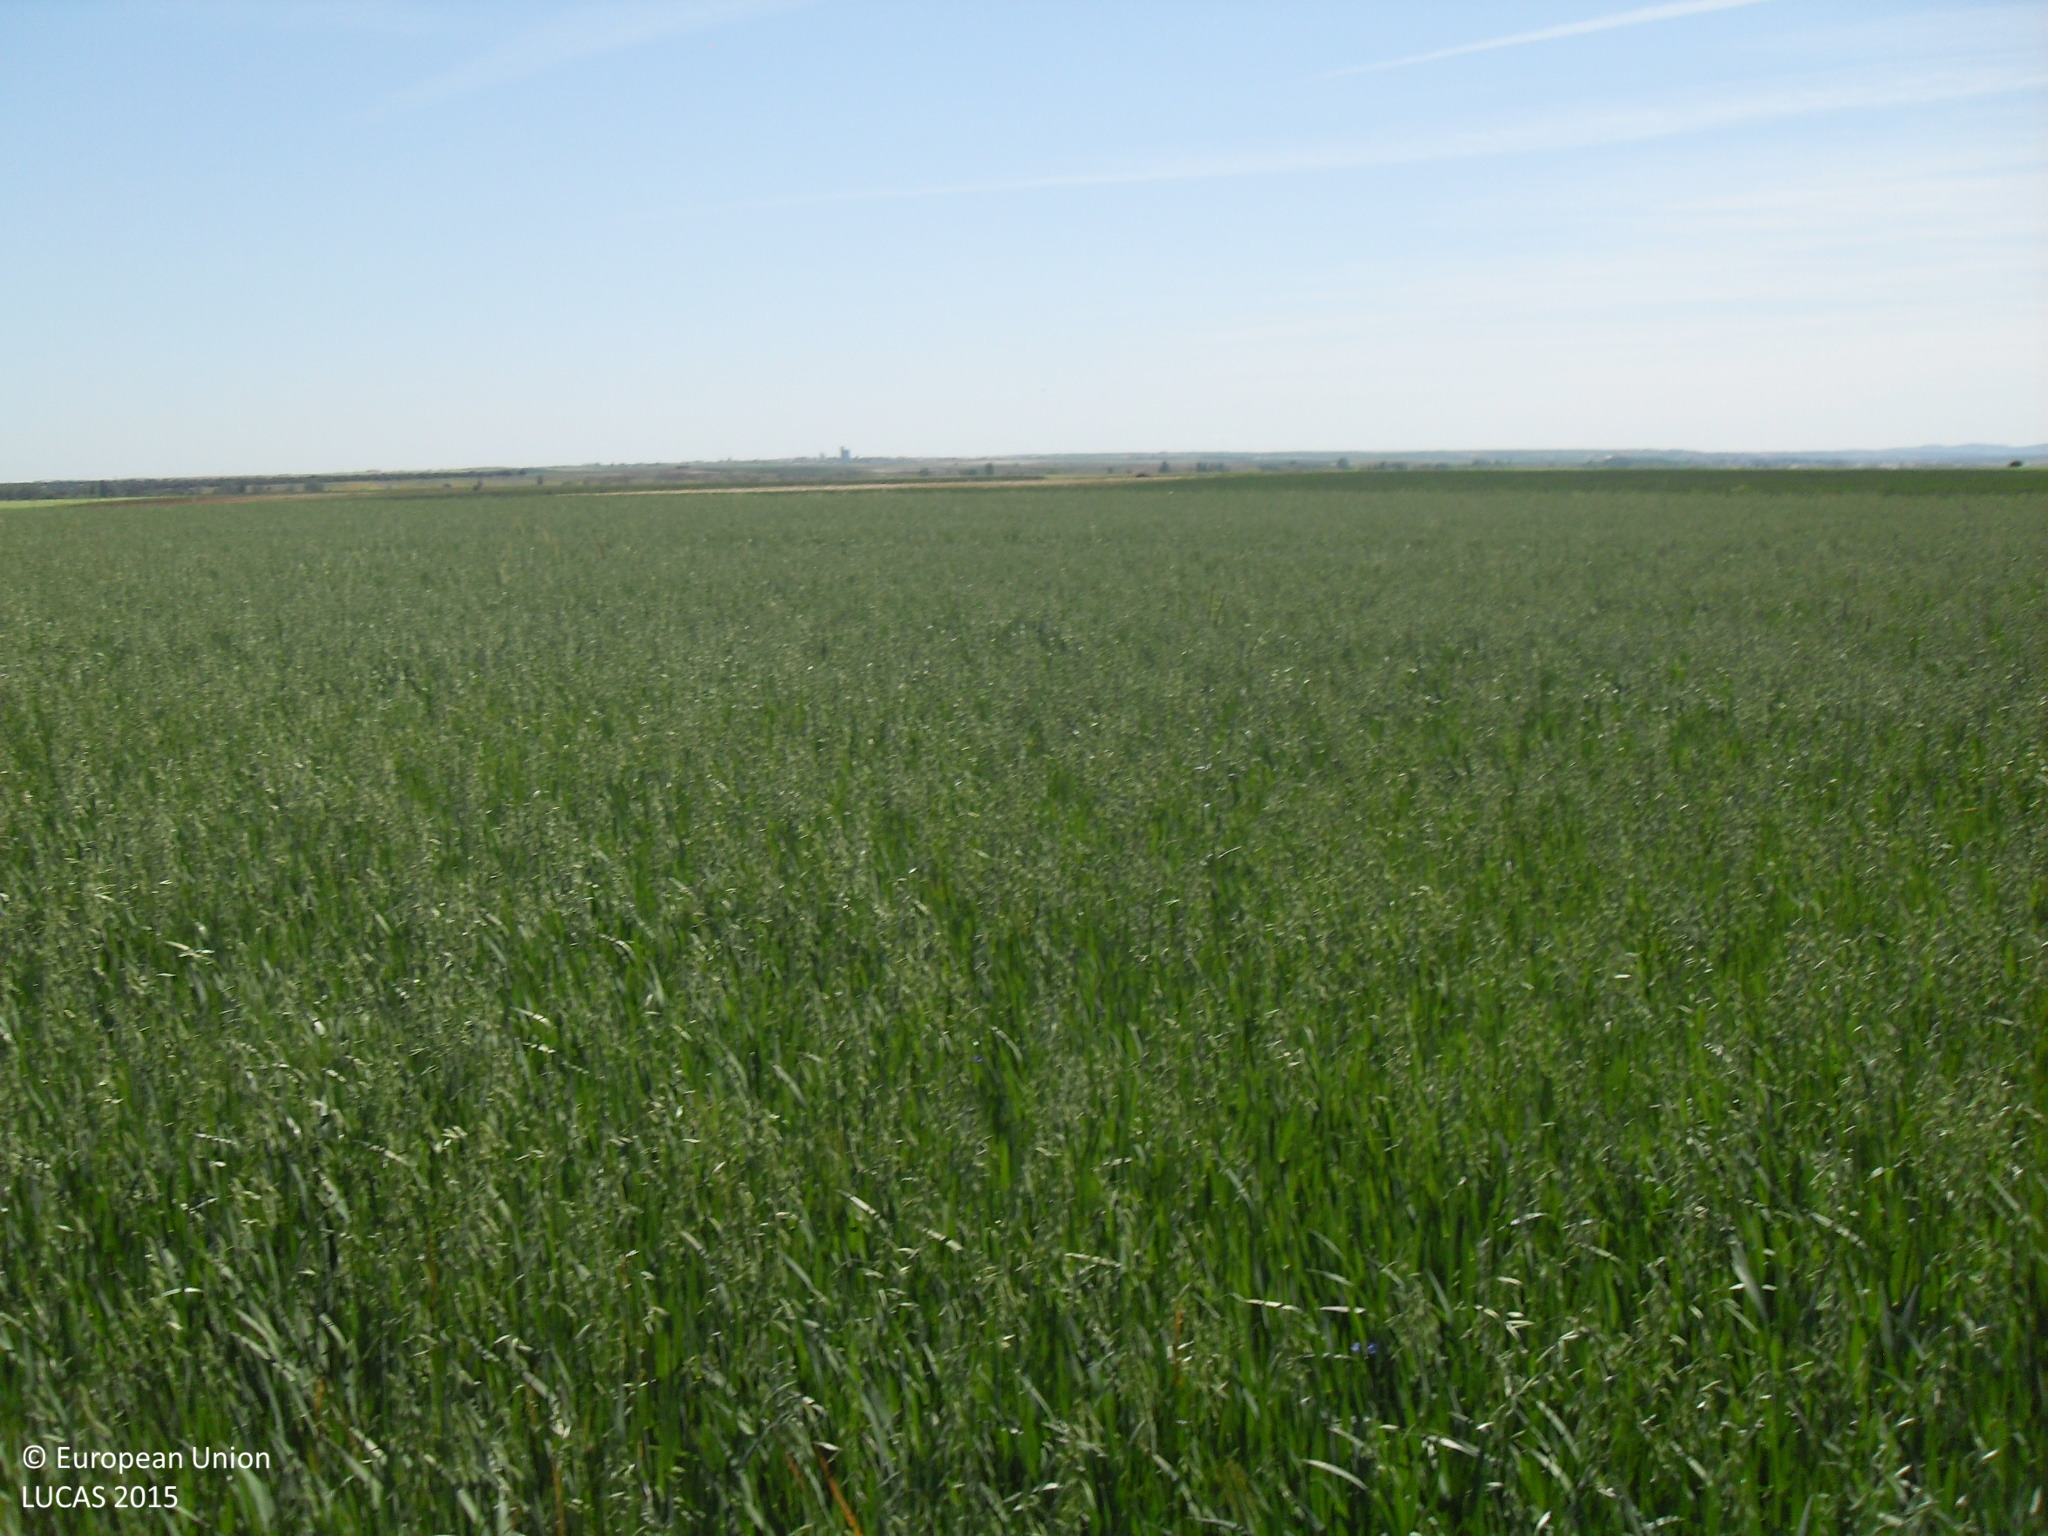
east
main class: Cropland
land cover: Oats
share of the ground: > 75 %
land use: Agriculture (excluding fallow land and kitchen gardens)
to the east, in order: Oats; Grass margins; Tracks; Grass margins; Common wheat
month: May
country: ES
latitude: 40.8929
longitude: -5.3217
